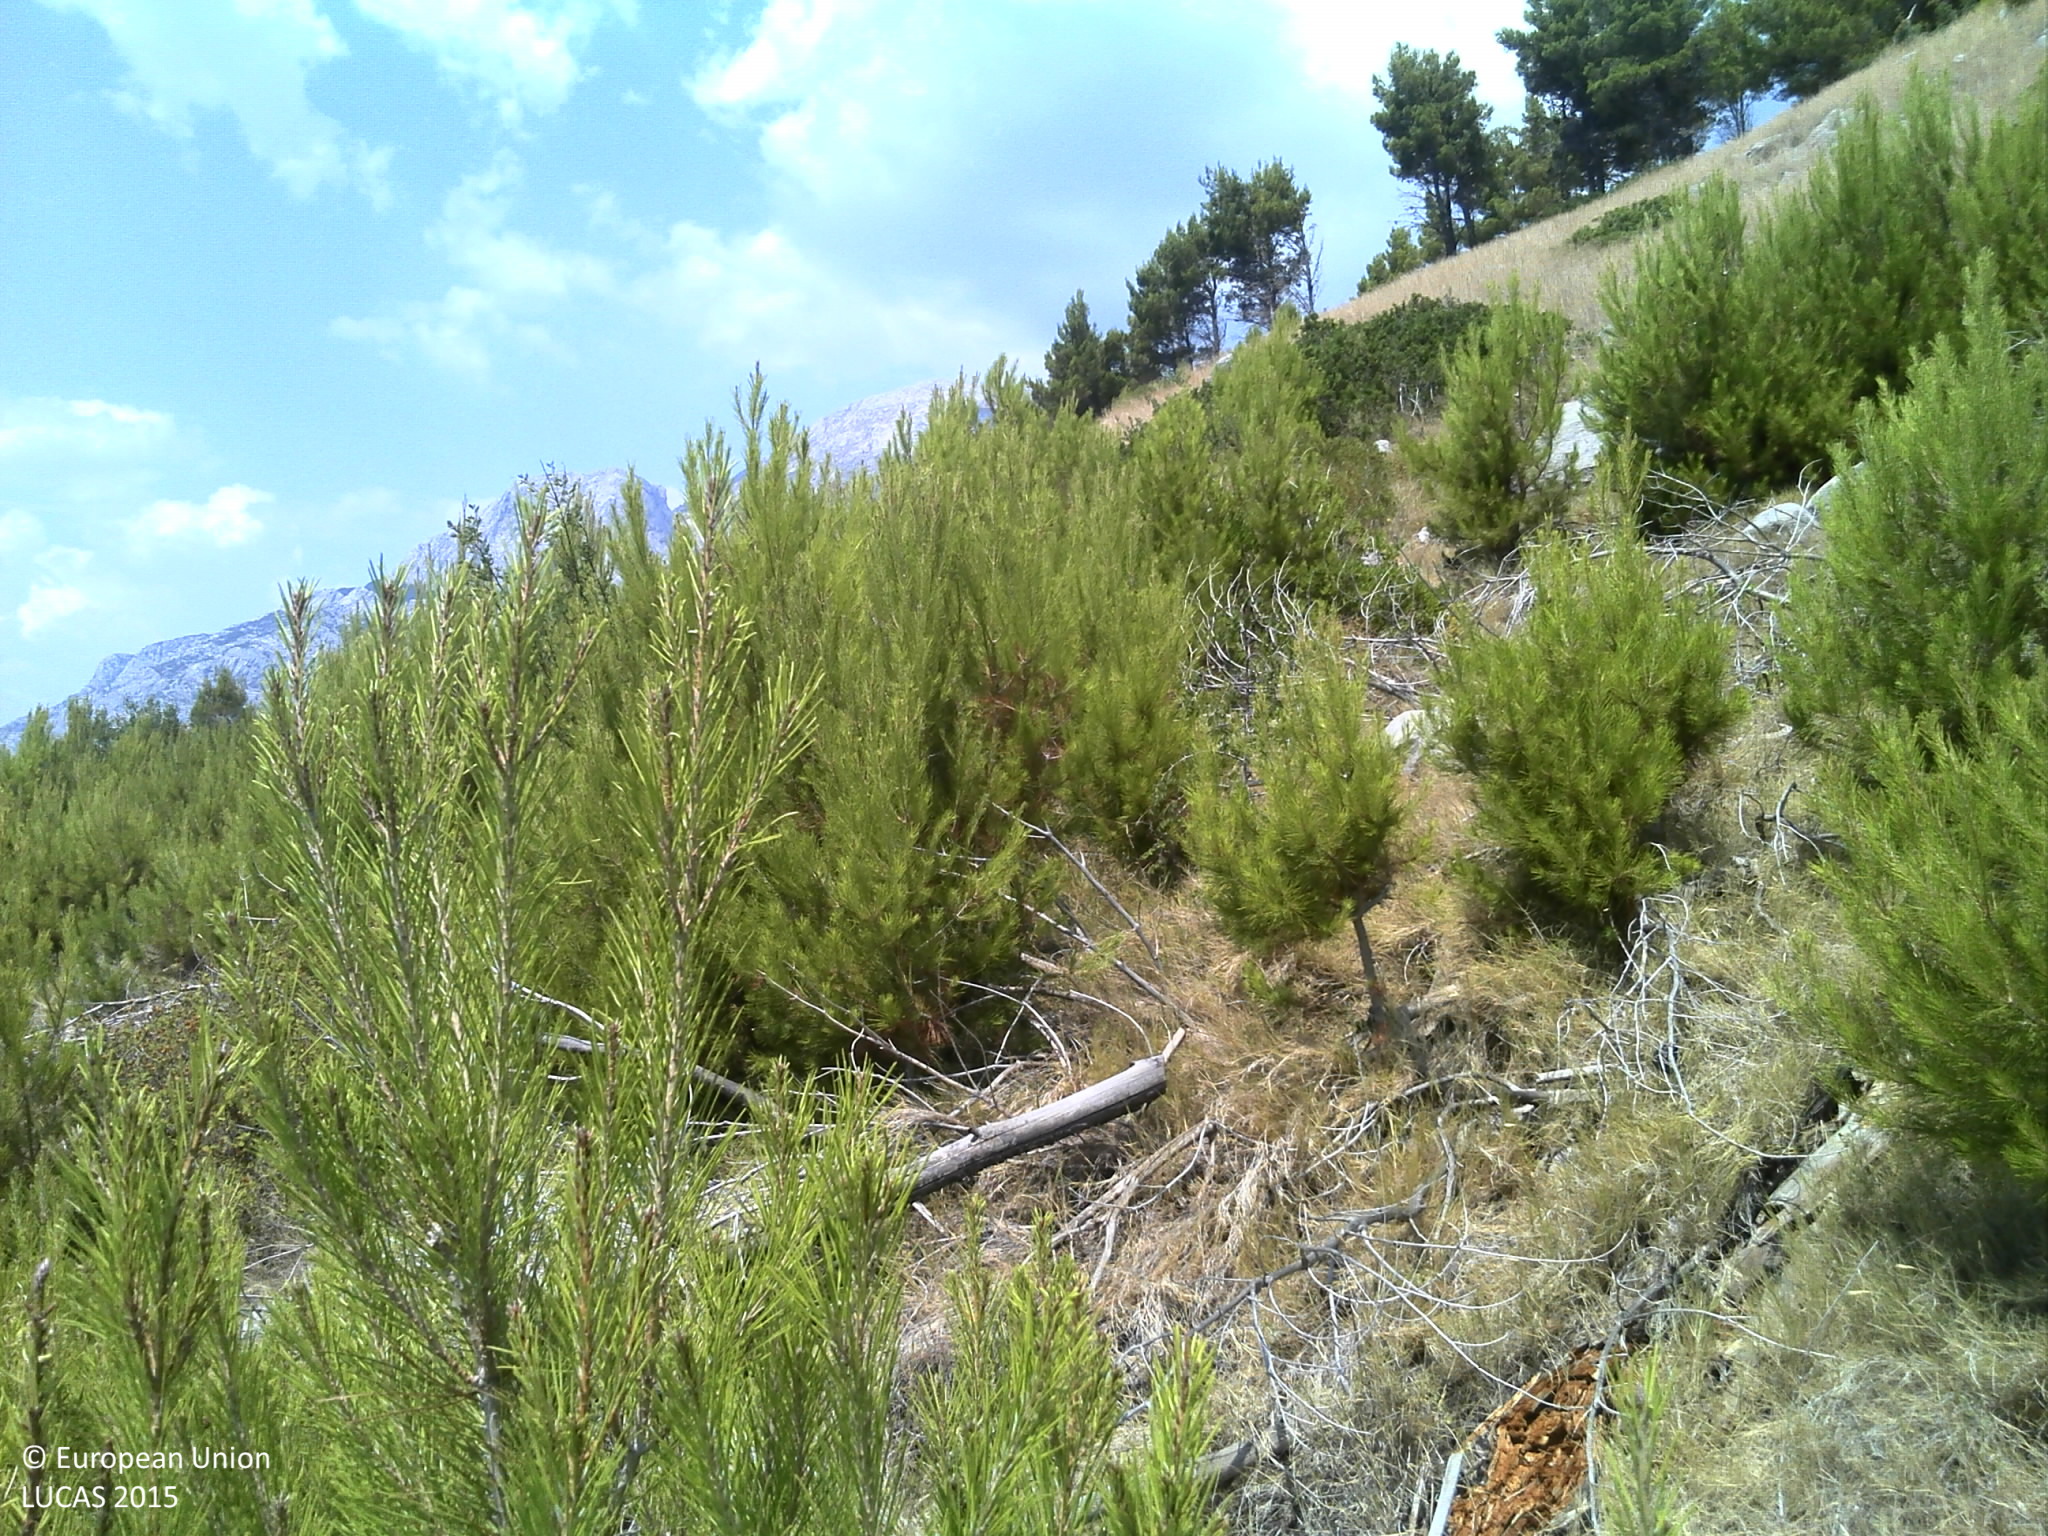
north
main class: Shrubland
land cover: Shrubland with sparse tree cover
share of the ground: > 75 %
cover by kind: shrubs 65 %, herbaceous plants 20 %, coniferous forest trees 5 %, consolidated bare surface 5 %, unconsolidated bare surface 5 %
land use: Semi-natural and natural areas not in use
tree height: < 5 m
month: August
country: HR
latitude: 43.3366
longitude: 16.9845
